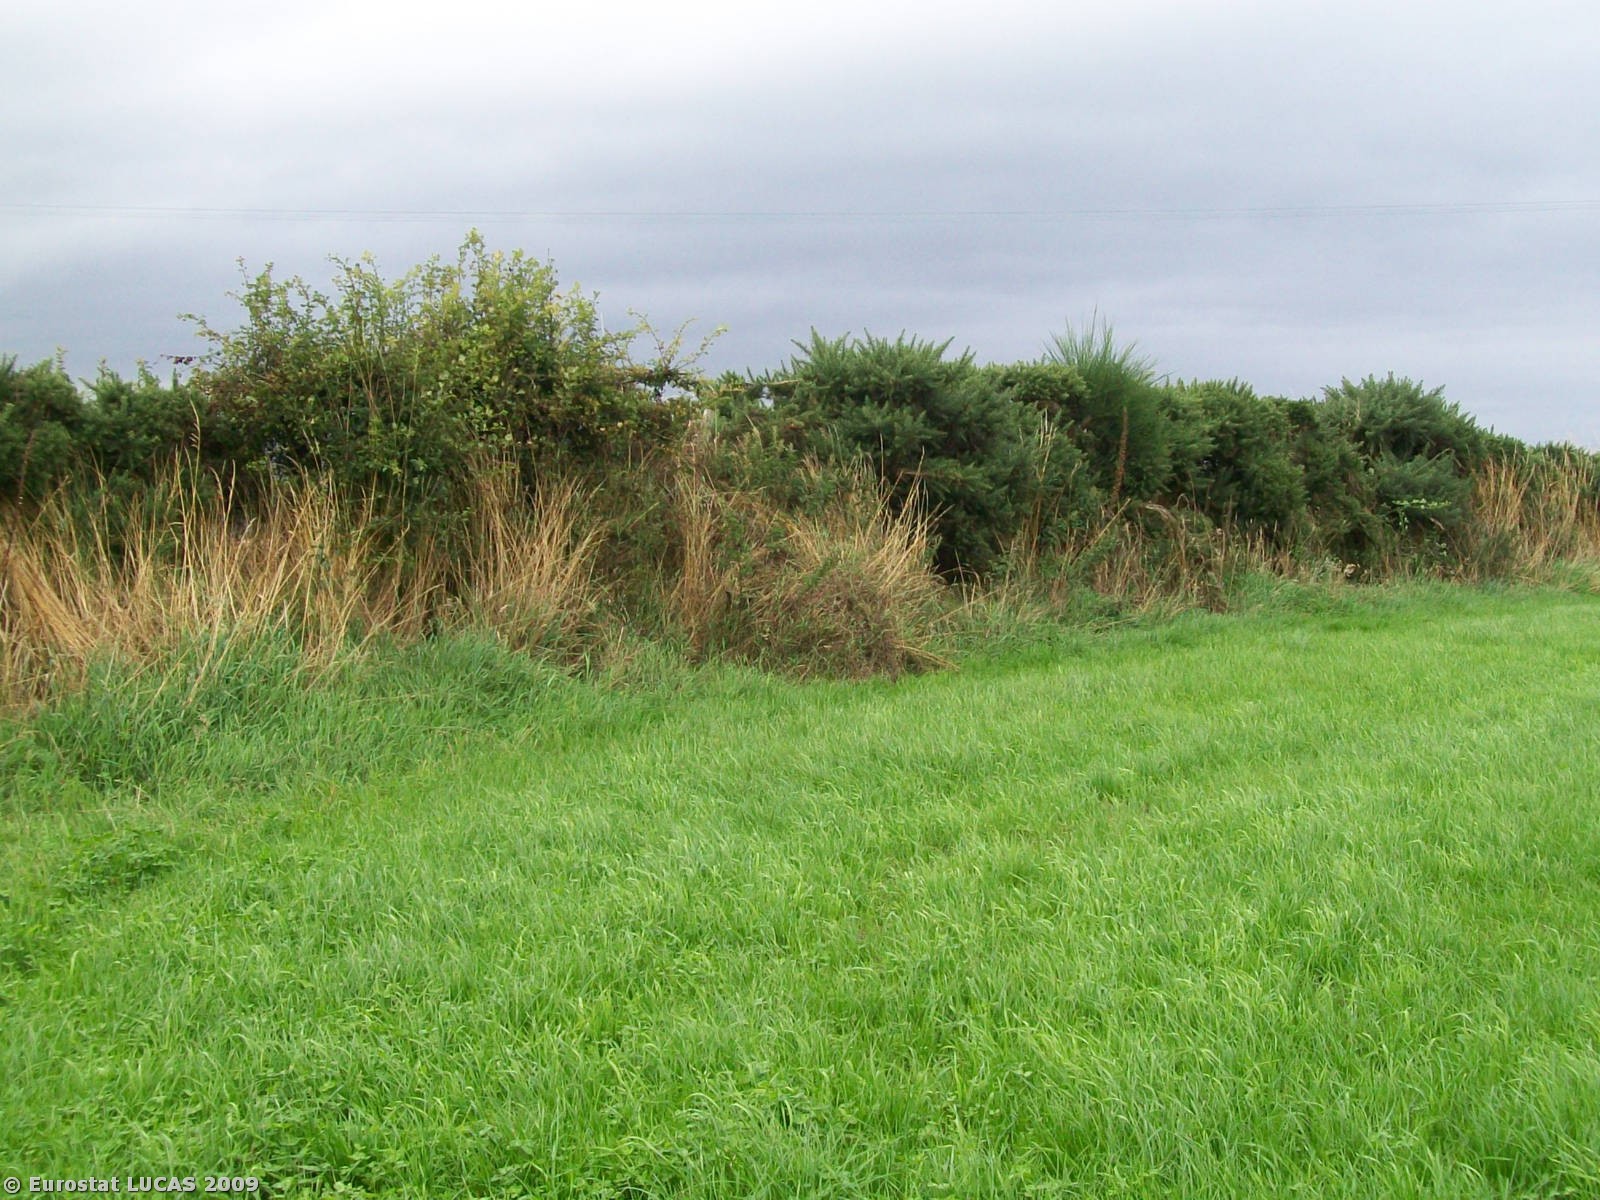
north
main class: Grassland
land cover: Grassland without tree/shrub cover
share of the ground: > 75 %
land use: Agriculture (excluding fallow land and kitchen gardens)
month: August
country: GB
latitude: 54.5200
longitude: -5.9435
